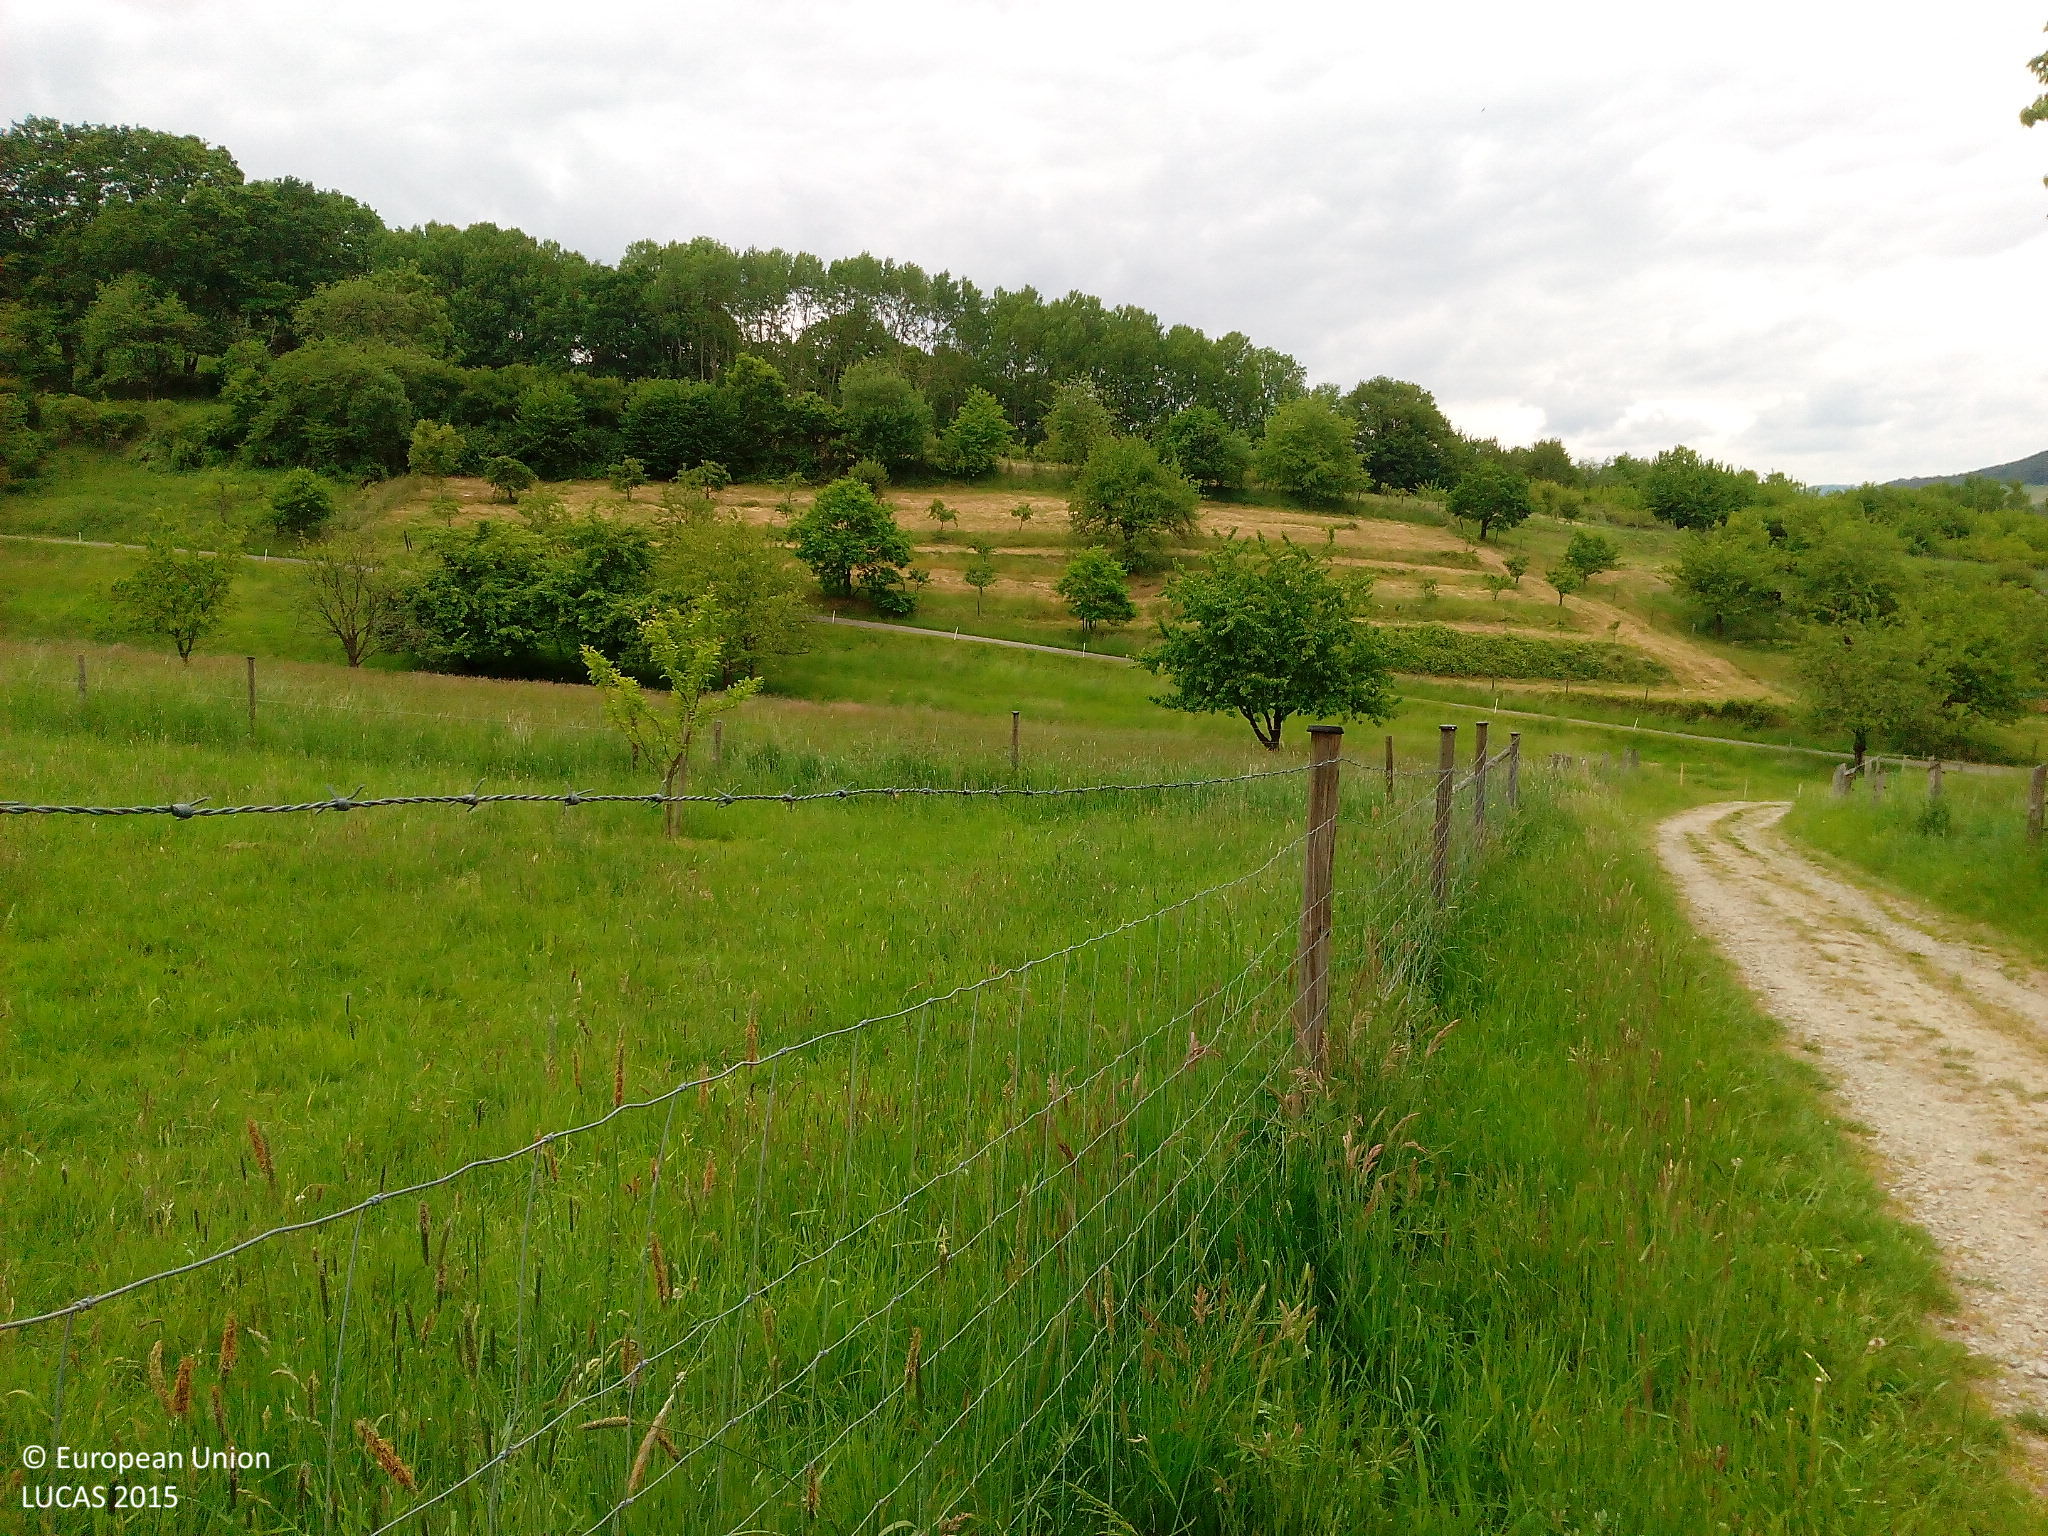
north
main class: Cropland
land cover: Cherry fruit
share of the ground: < 10 %
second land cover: Grassland without tree/shrub cover
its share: > 75 %
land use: Agriculture (excluding fallow land and kitchen gardens)
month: May
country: DE
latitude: 51.3169
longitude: 9.8709
